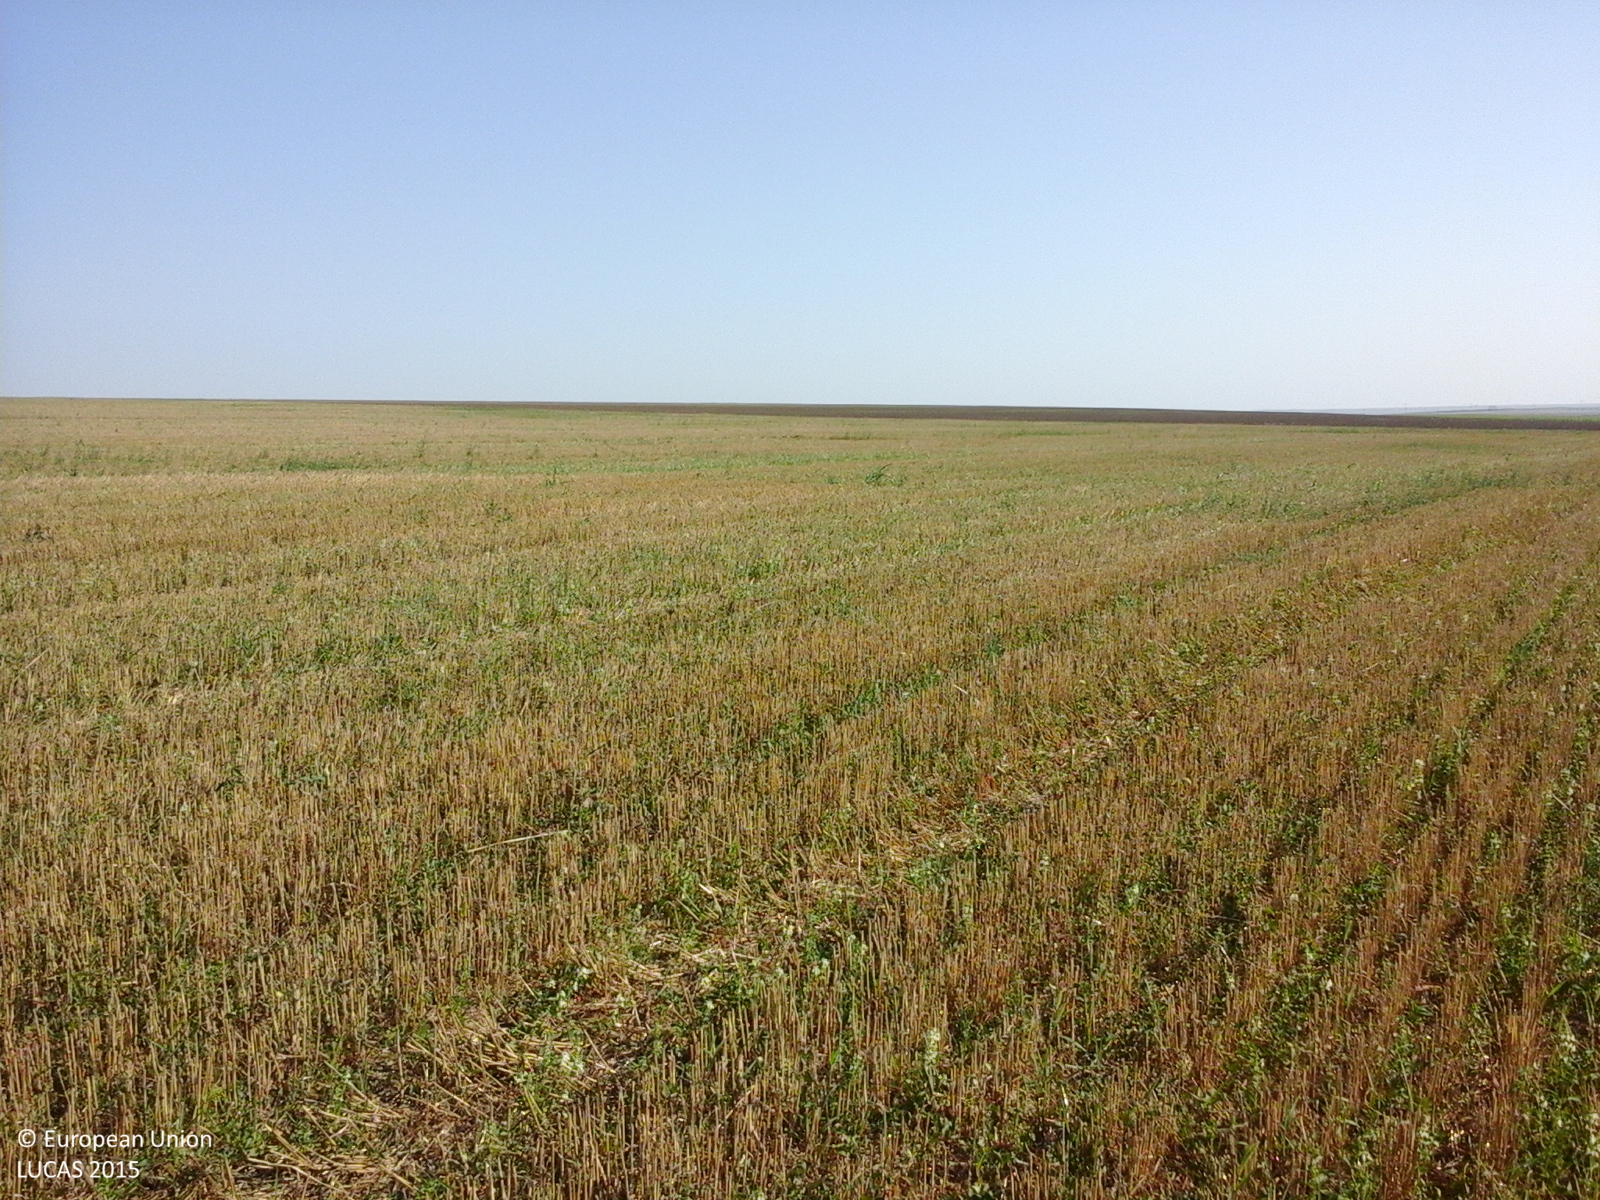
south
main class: Cropland
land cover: Common wheat
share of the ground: > 75 %
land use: Agriculture (excluding fallow land and kitchen gardens)
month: August
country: RO
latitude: 44.3369
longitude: 28.3660
